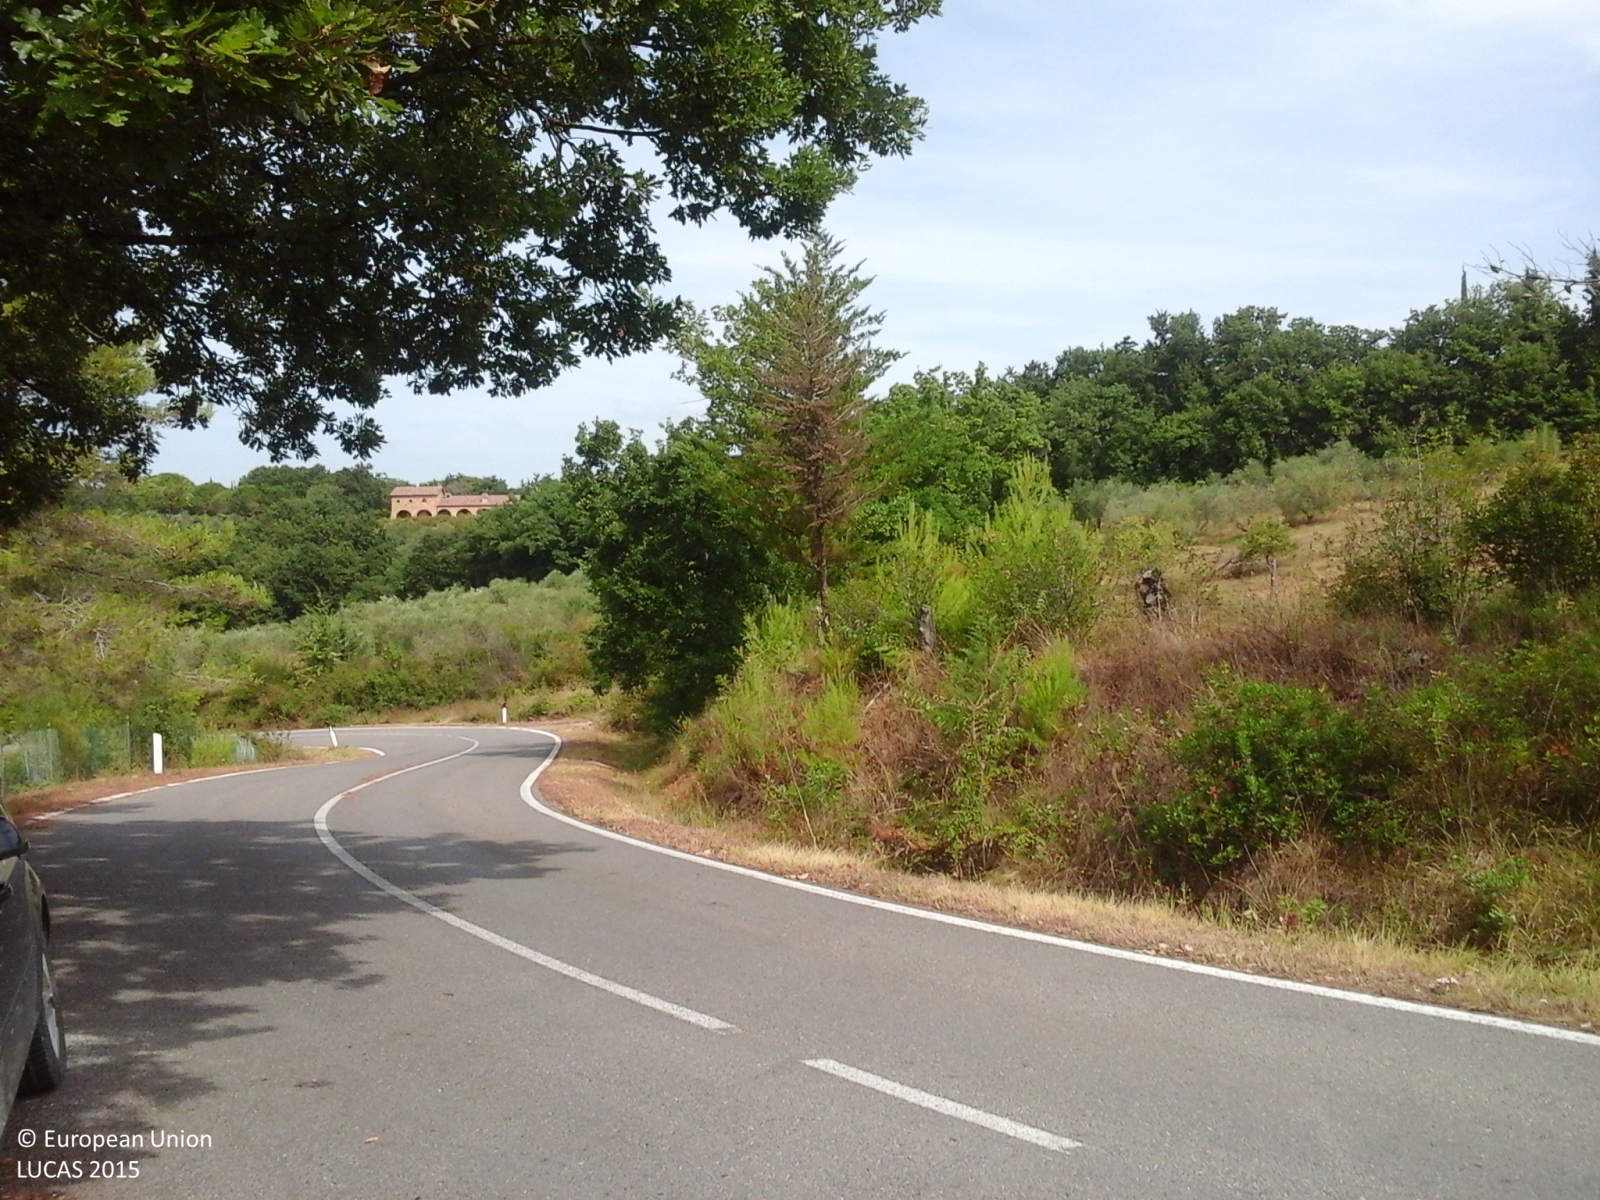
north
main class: Woodland
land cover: Broadleaved woodland
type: broadleaved evergreen forest
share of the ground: > 75 %
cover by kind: broadleaved forest trees 80 %, coniferous forest trees 20 %
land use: Forestry
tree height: > 5 m
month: August
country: IT
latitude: 42.9023
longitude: 10.9645
